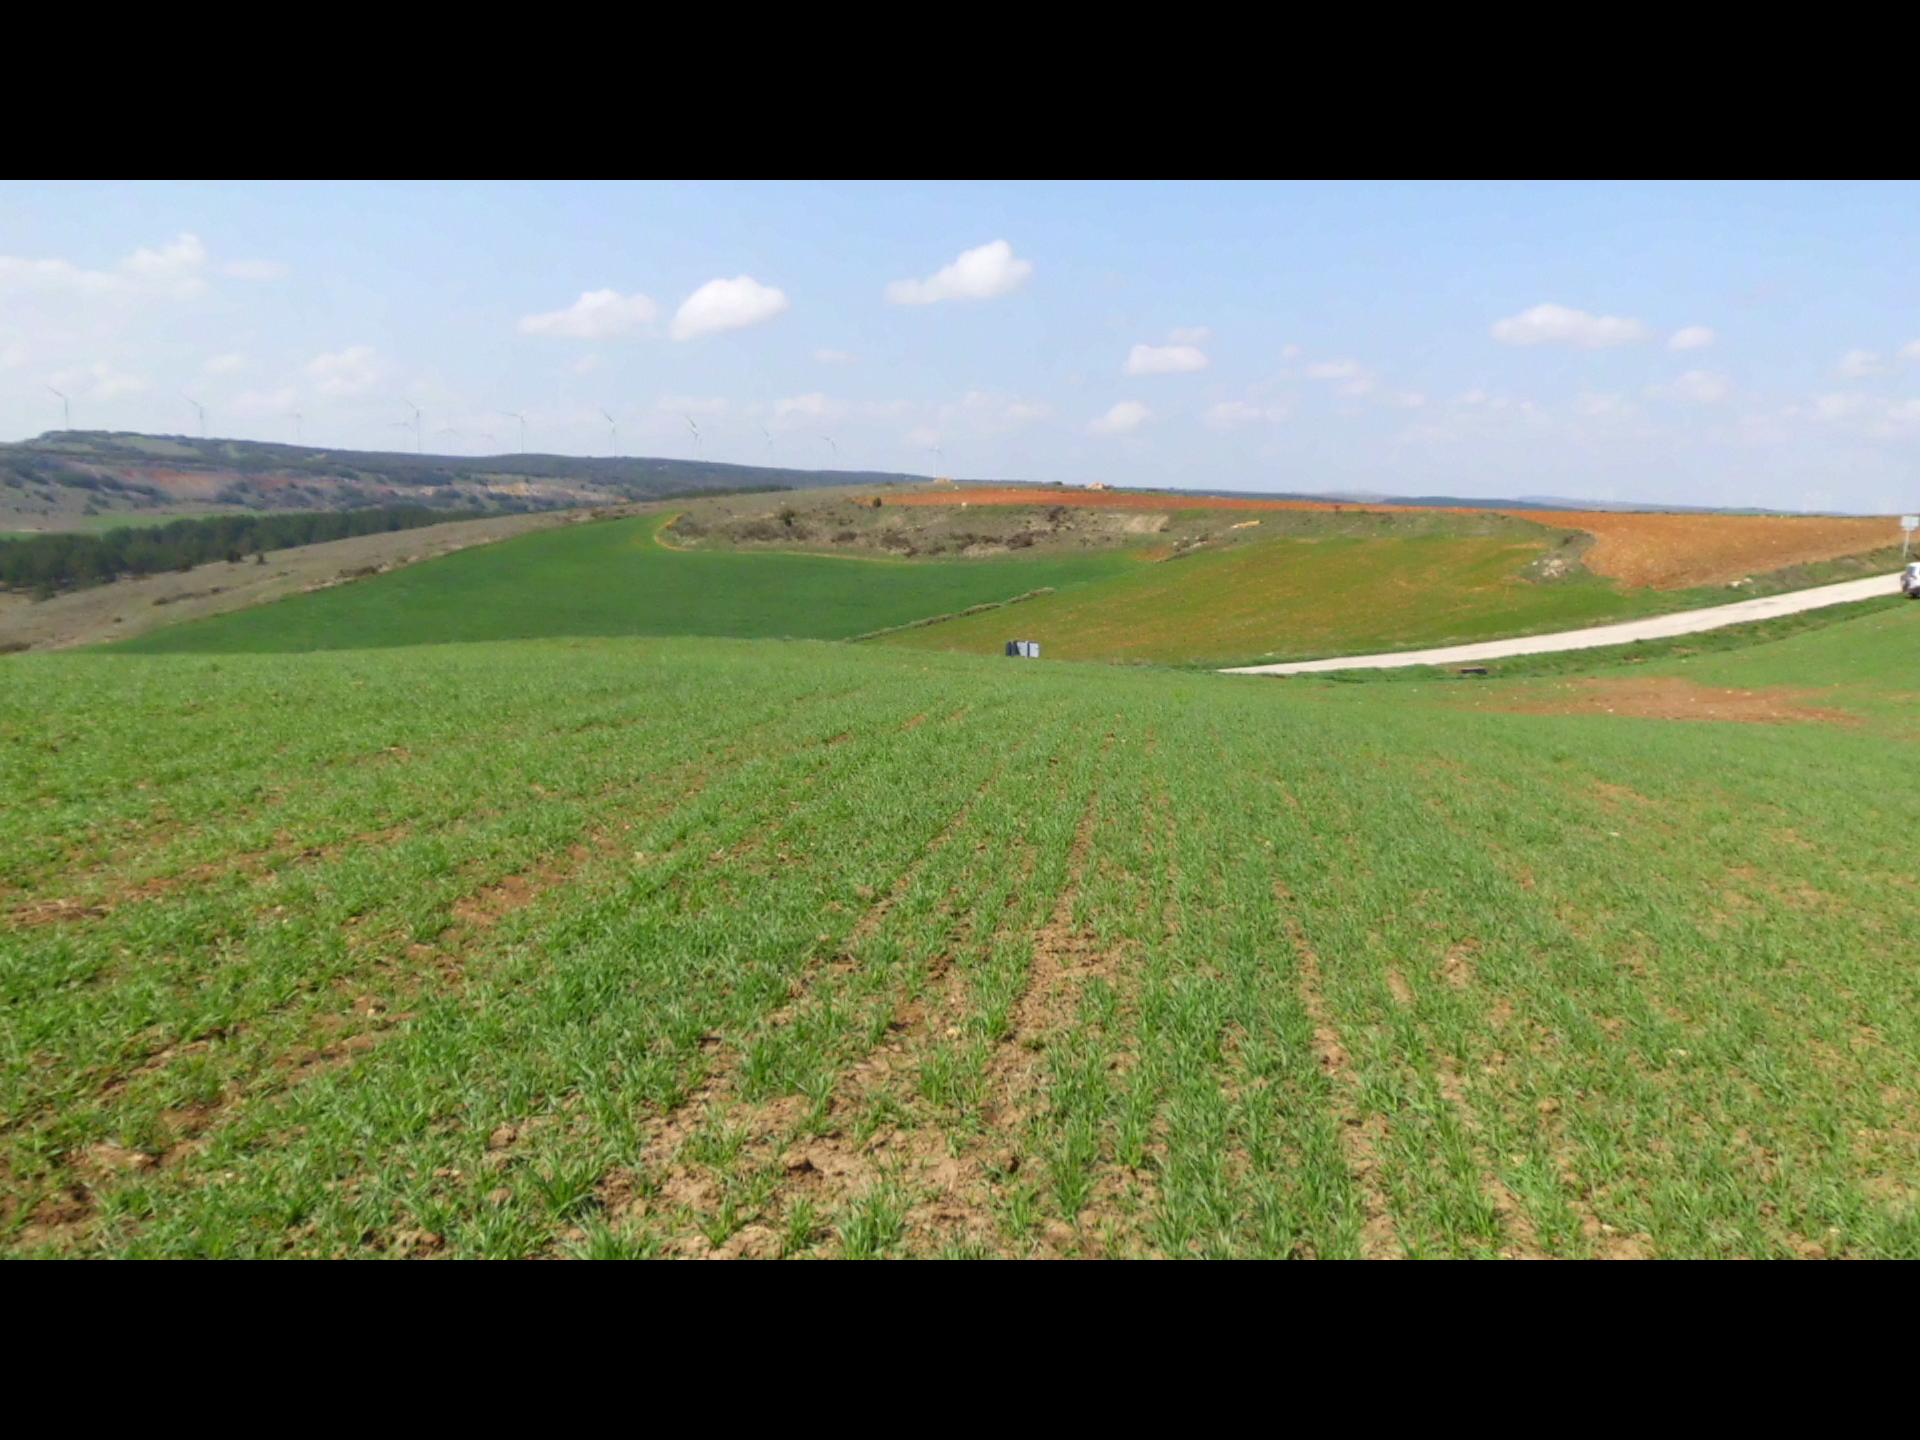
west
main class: Cropland
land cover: Barley
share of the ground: > 75 %
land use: Agriculture (excluding fallow land and kitchen gardens)
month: April
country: ES
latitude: 42.5218
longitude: -3.7083
